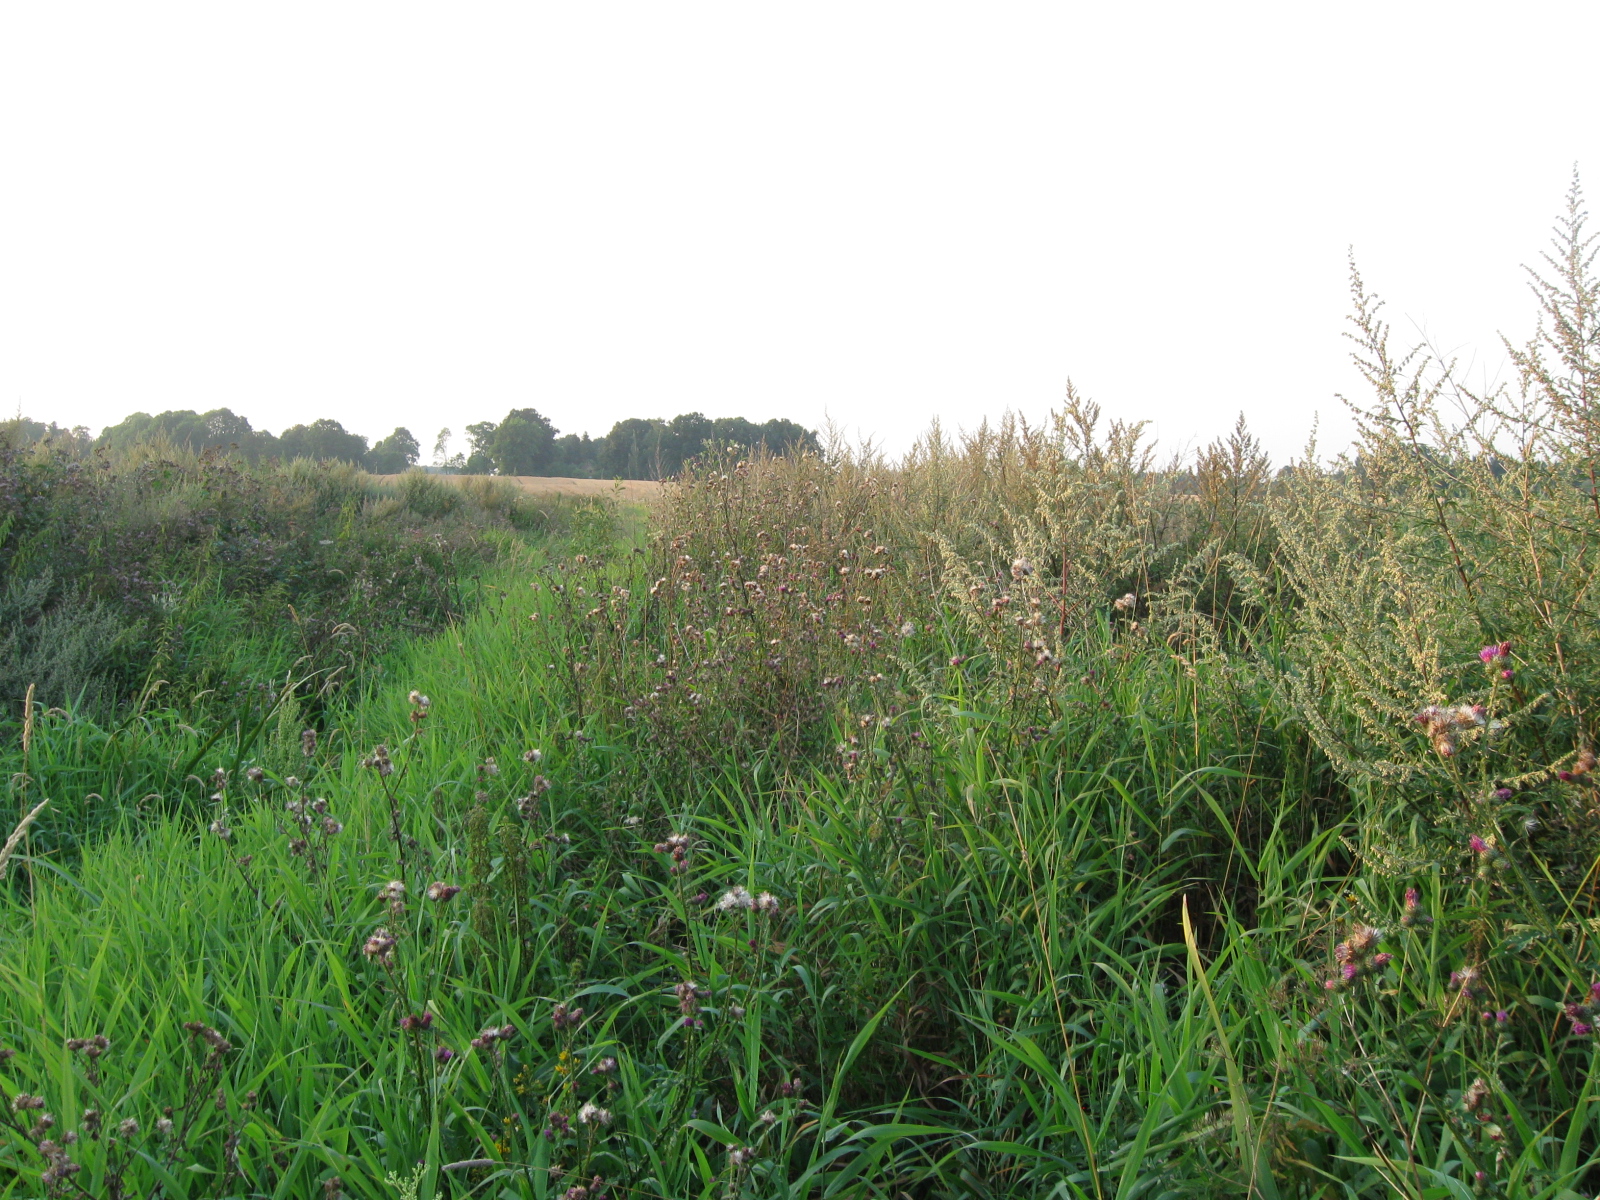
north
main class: Grassland
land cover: Spontaneously vegetated surfaces
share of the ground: > 75 %
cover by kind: herbaceous plants 100 %
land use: Semi-natural and natural areas not in use
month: August
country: LT
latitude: 54.6521
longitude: 23.2984
